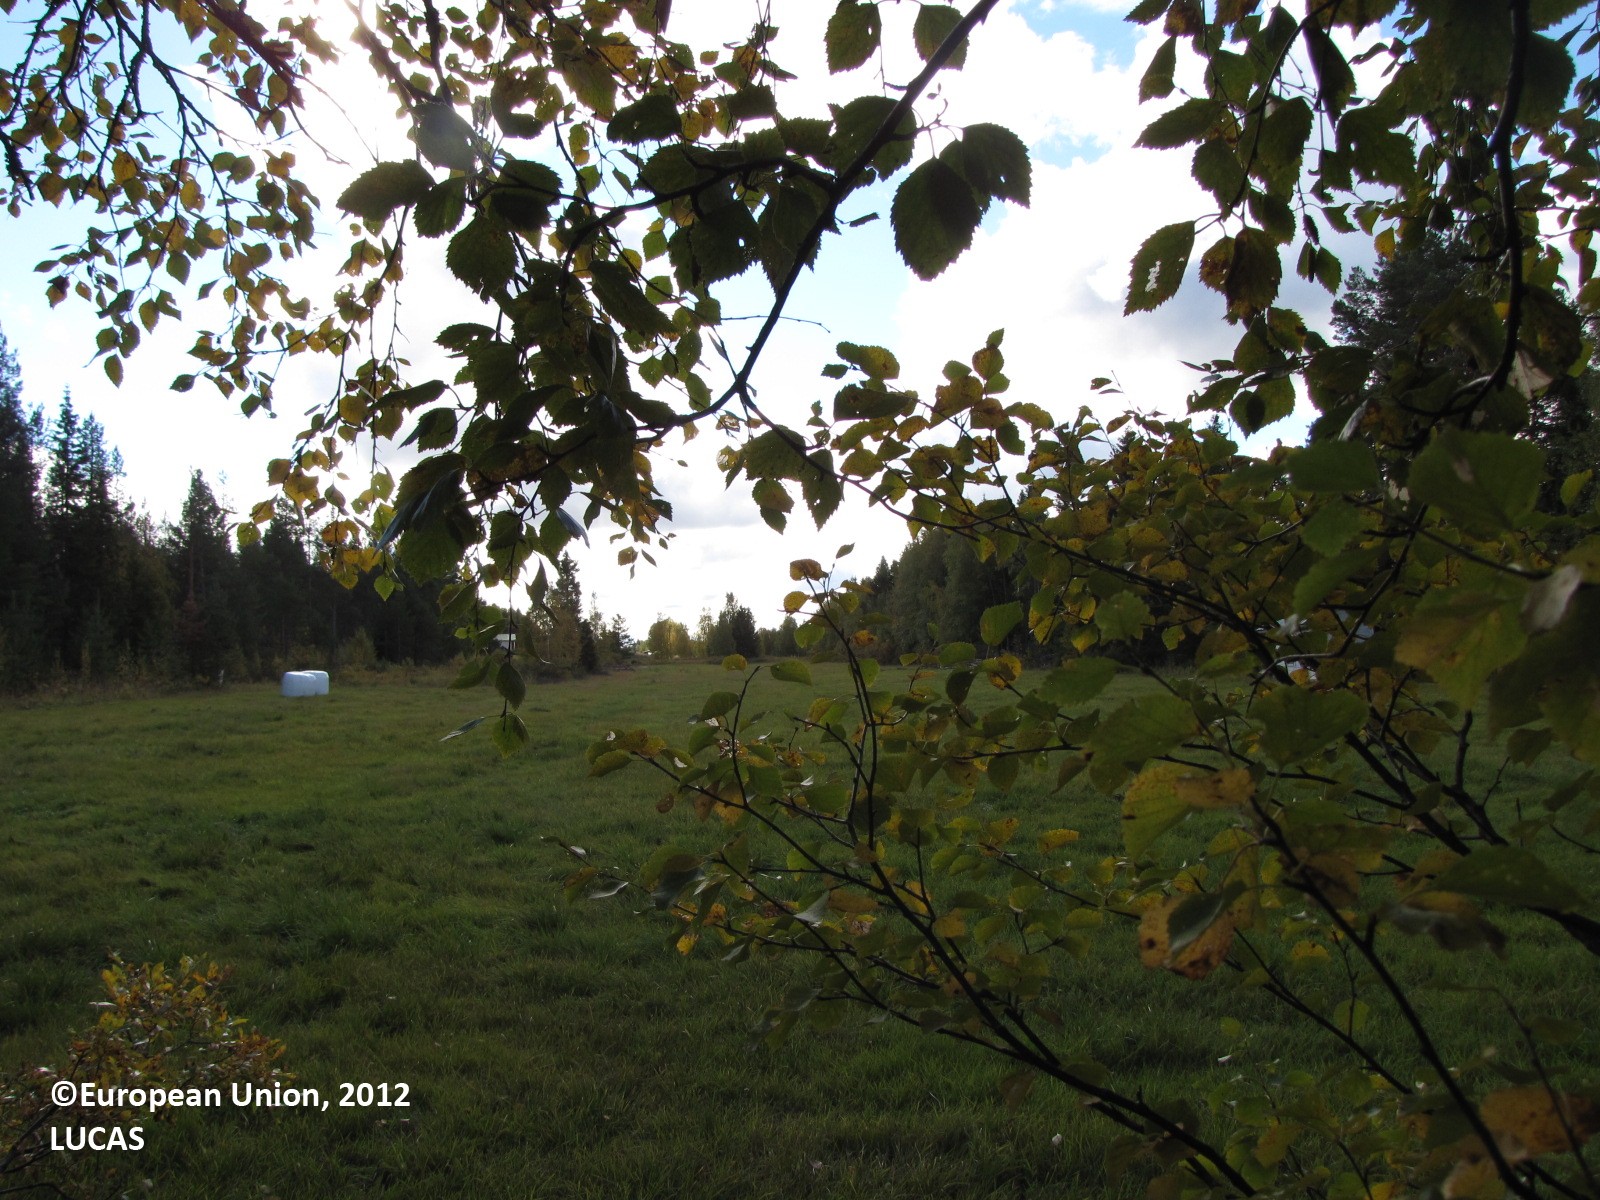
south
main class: Woodland
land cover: Pine dominated mixed woodland
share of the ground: 10 - 25 %
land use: Forestry
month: September
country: FI
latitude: 67.3706
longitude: 24.8745
